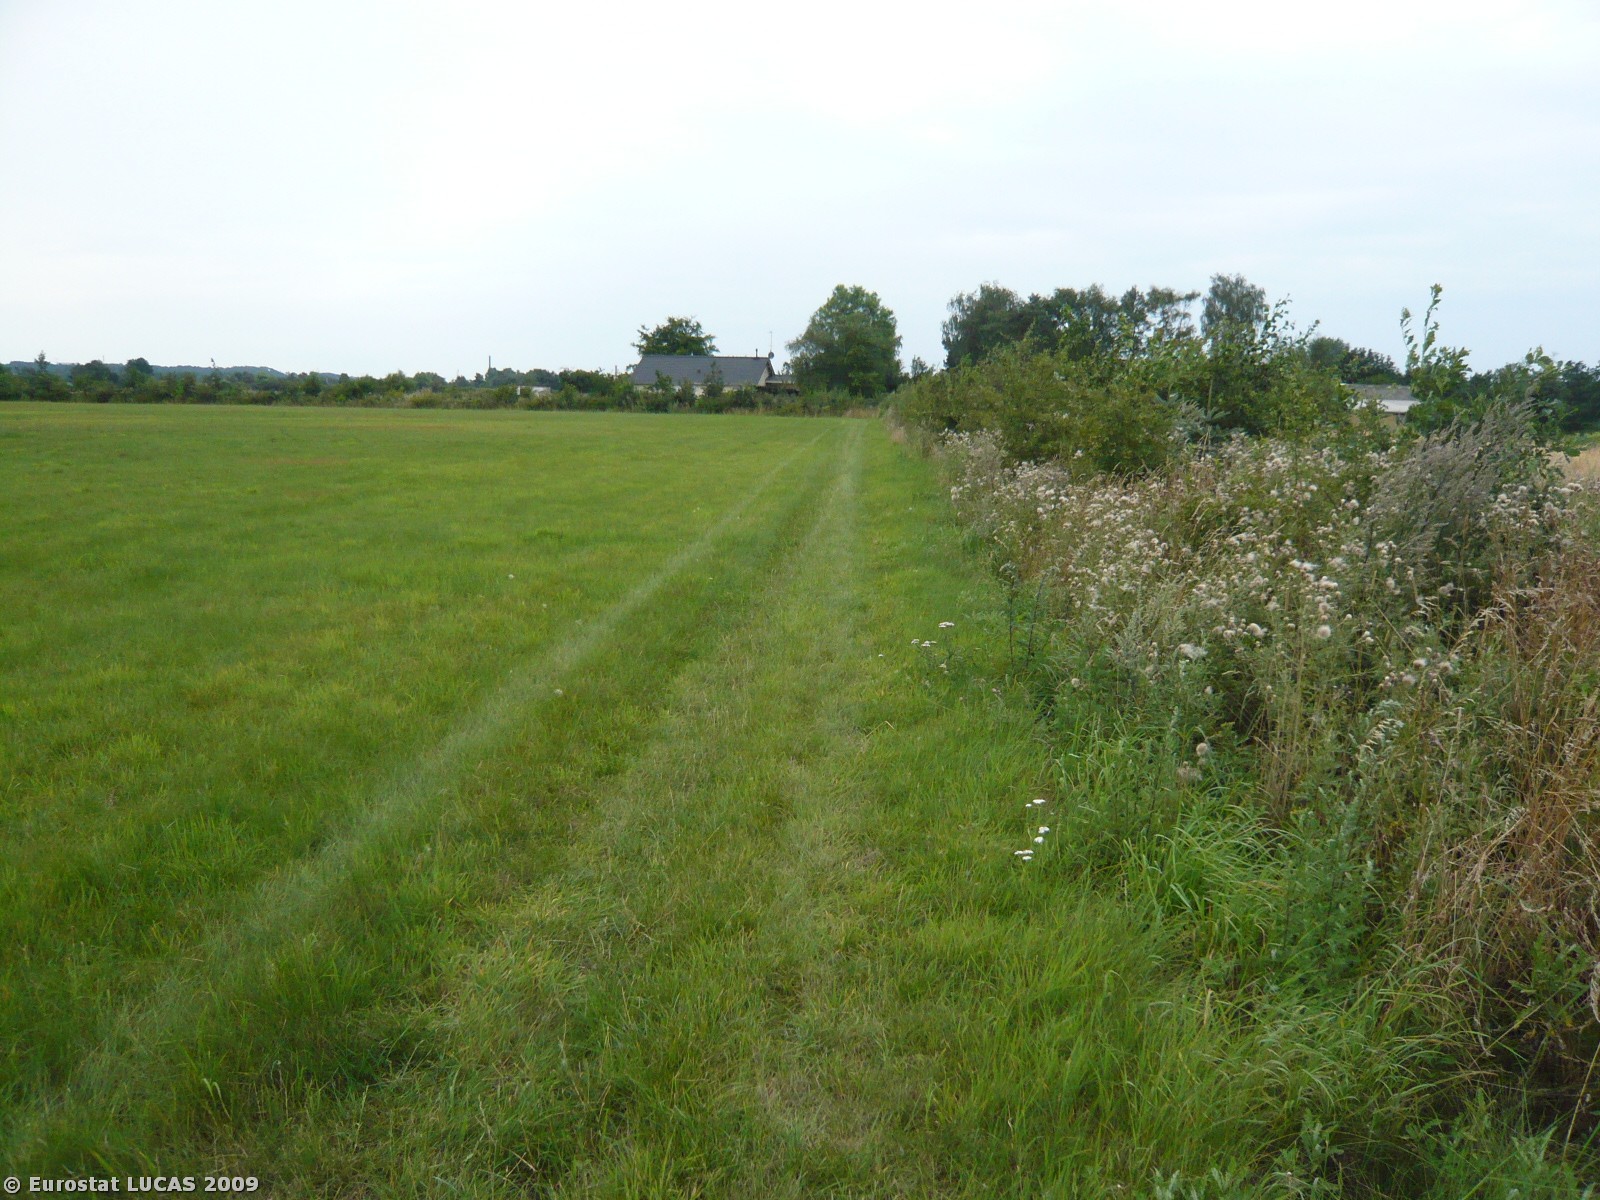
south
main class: Grassland
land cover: Grassland without tree/shrub cover
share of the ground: > 75 %
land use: Agriculture (excluding fallow land and kitchen gardens)
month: August
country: DK
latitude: 55.9923
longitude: 12.0020
